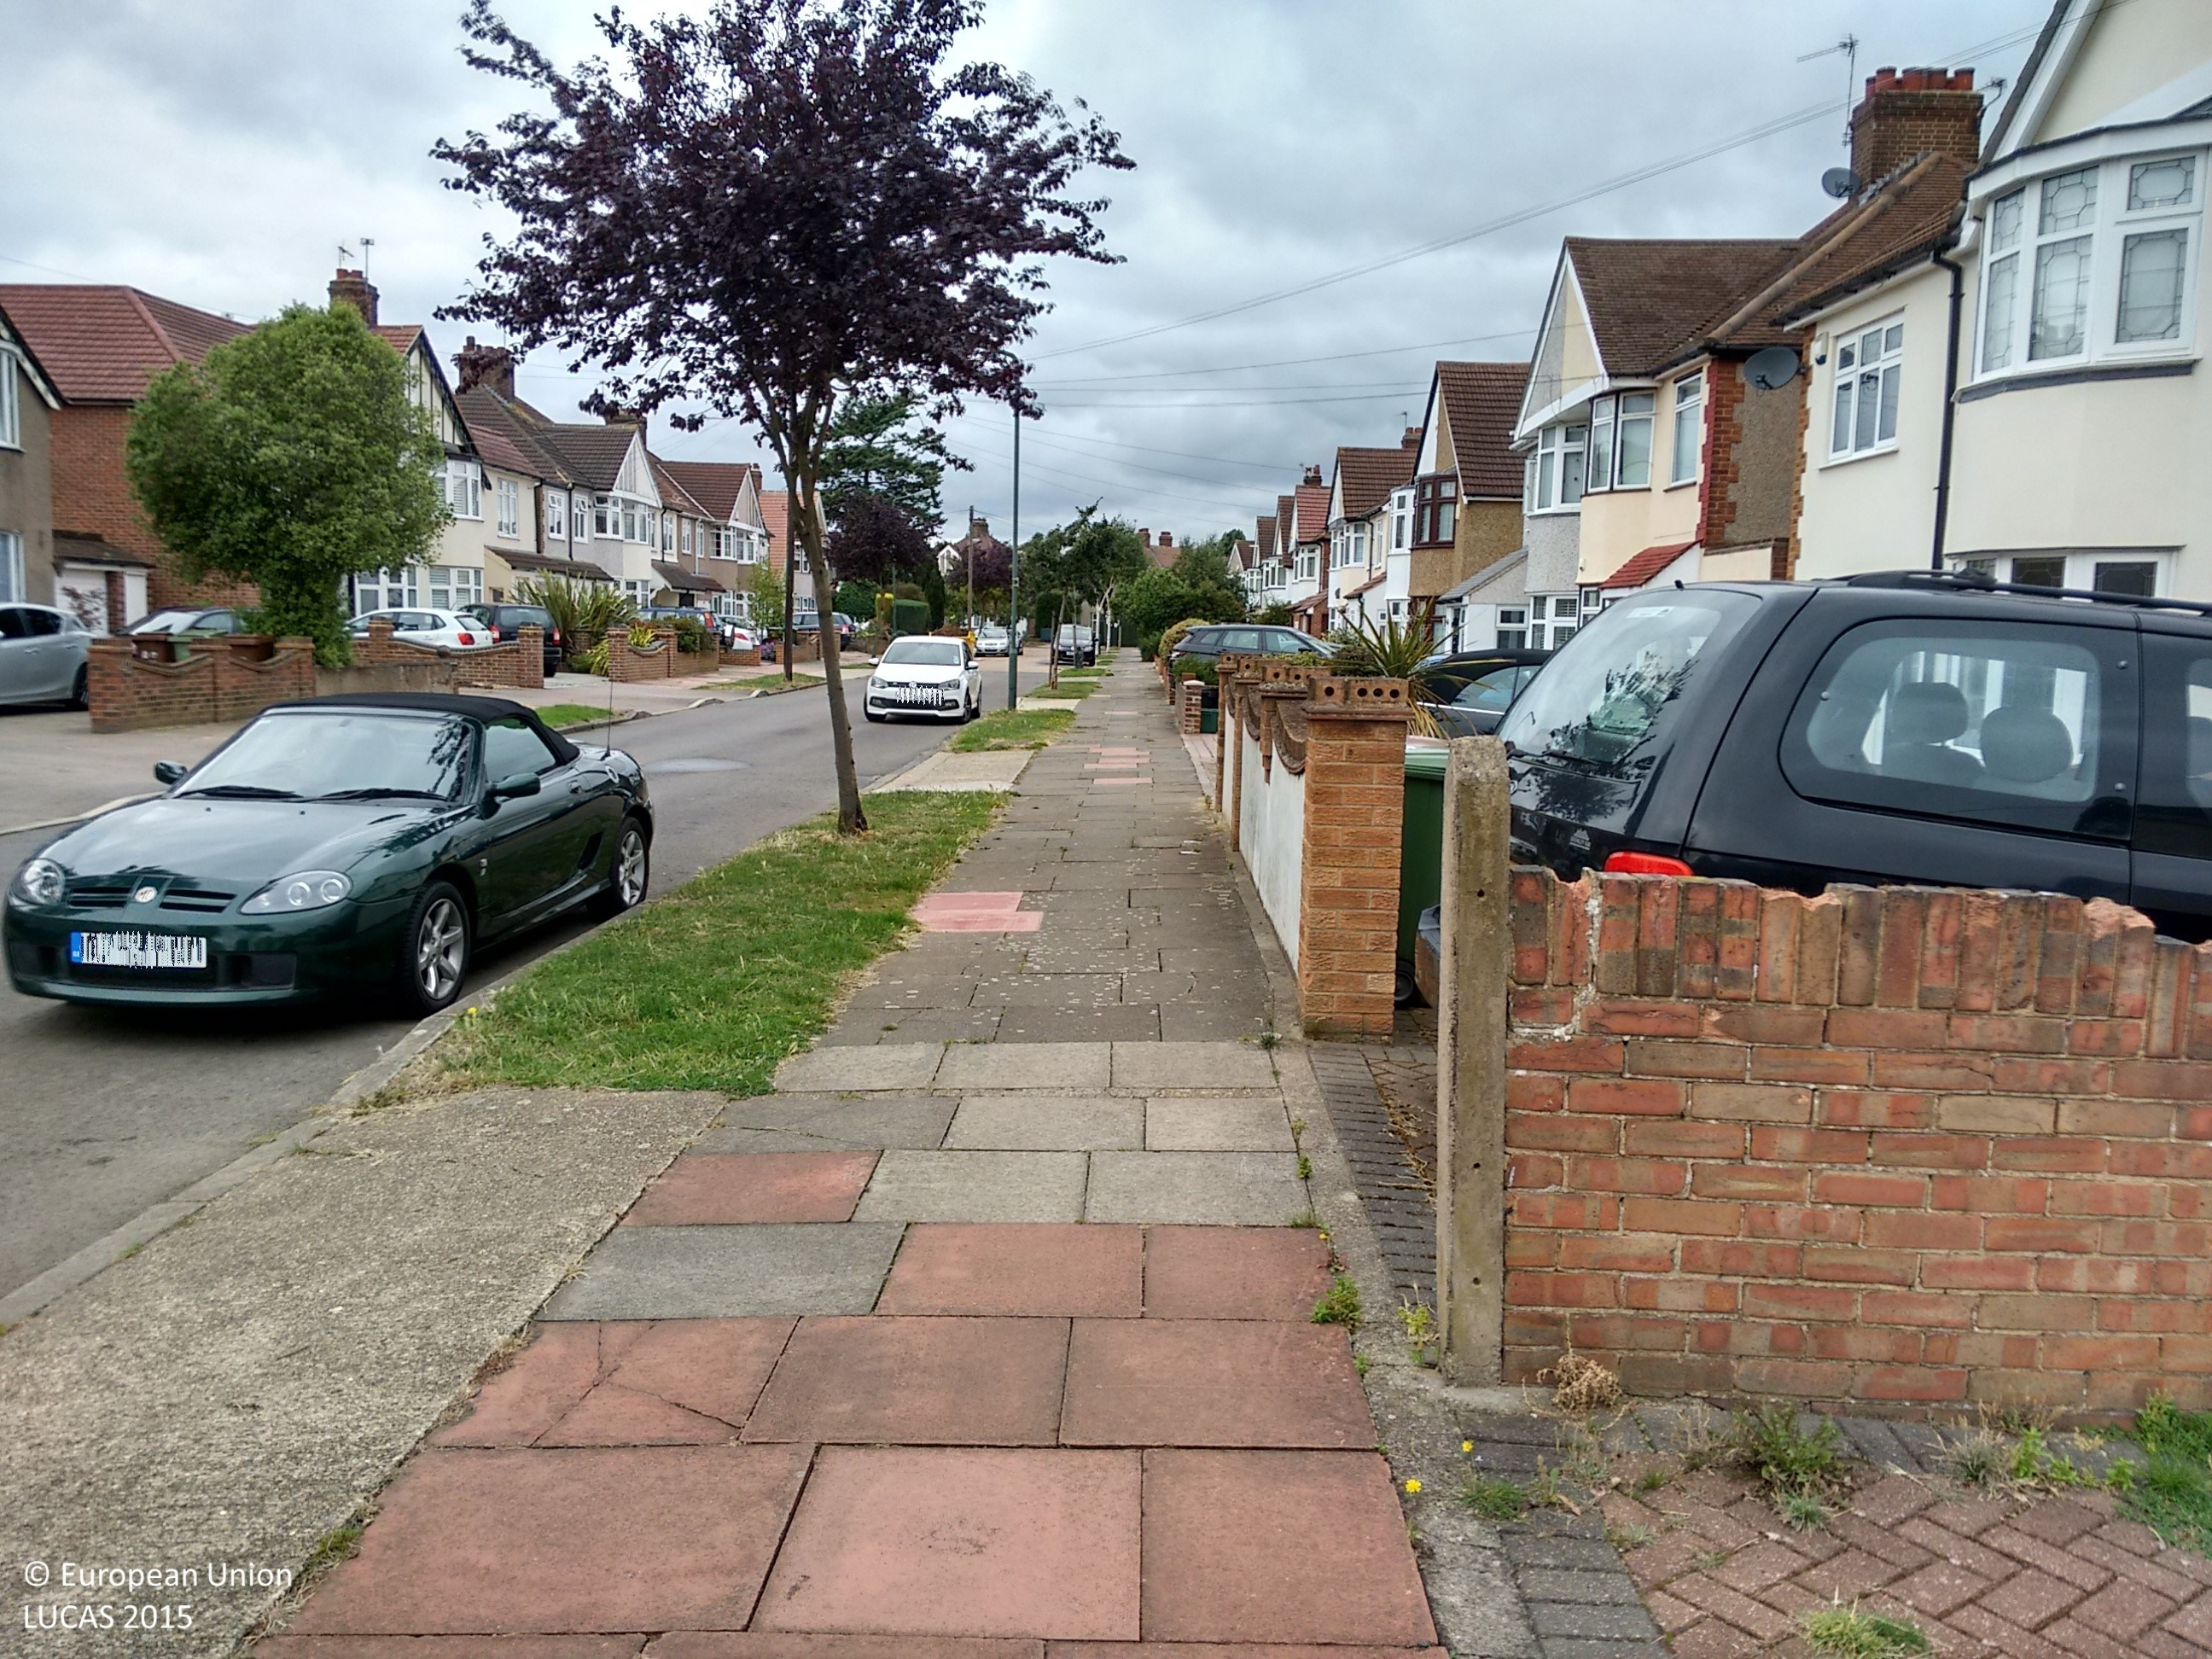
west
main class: Cropland
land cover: Other fresh vegetables
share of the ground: > 75 %
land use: Kitchen garden
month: August
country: GB
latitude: 51.4361
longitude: 0.0853
